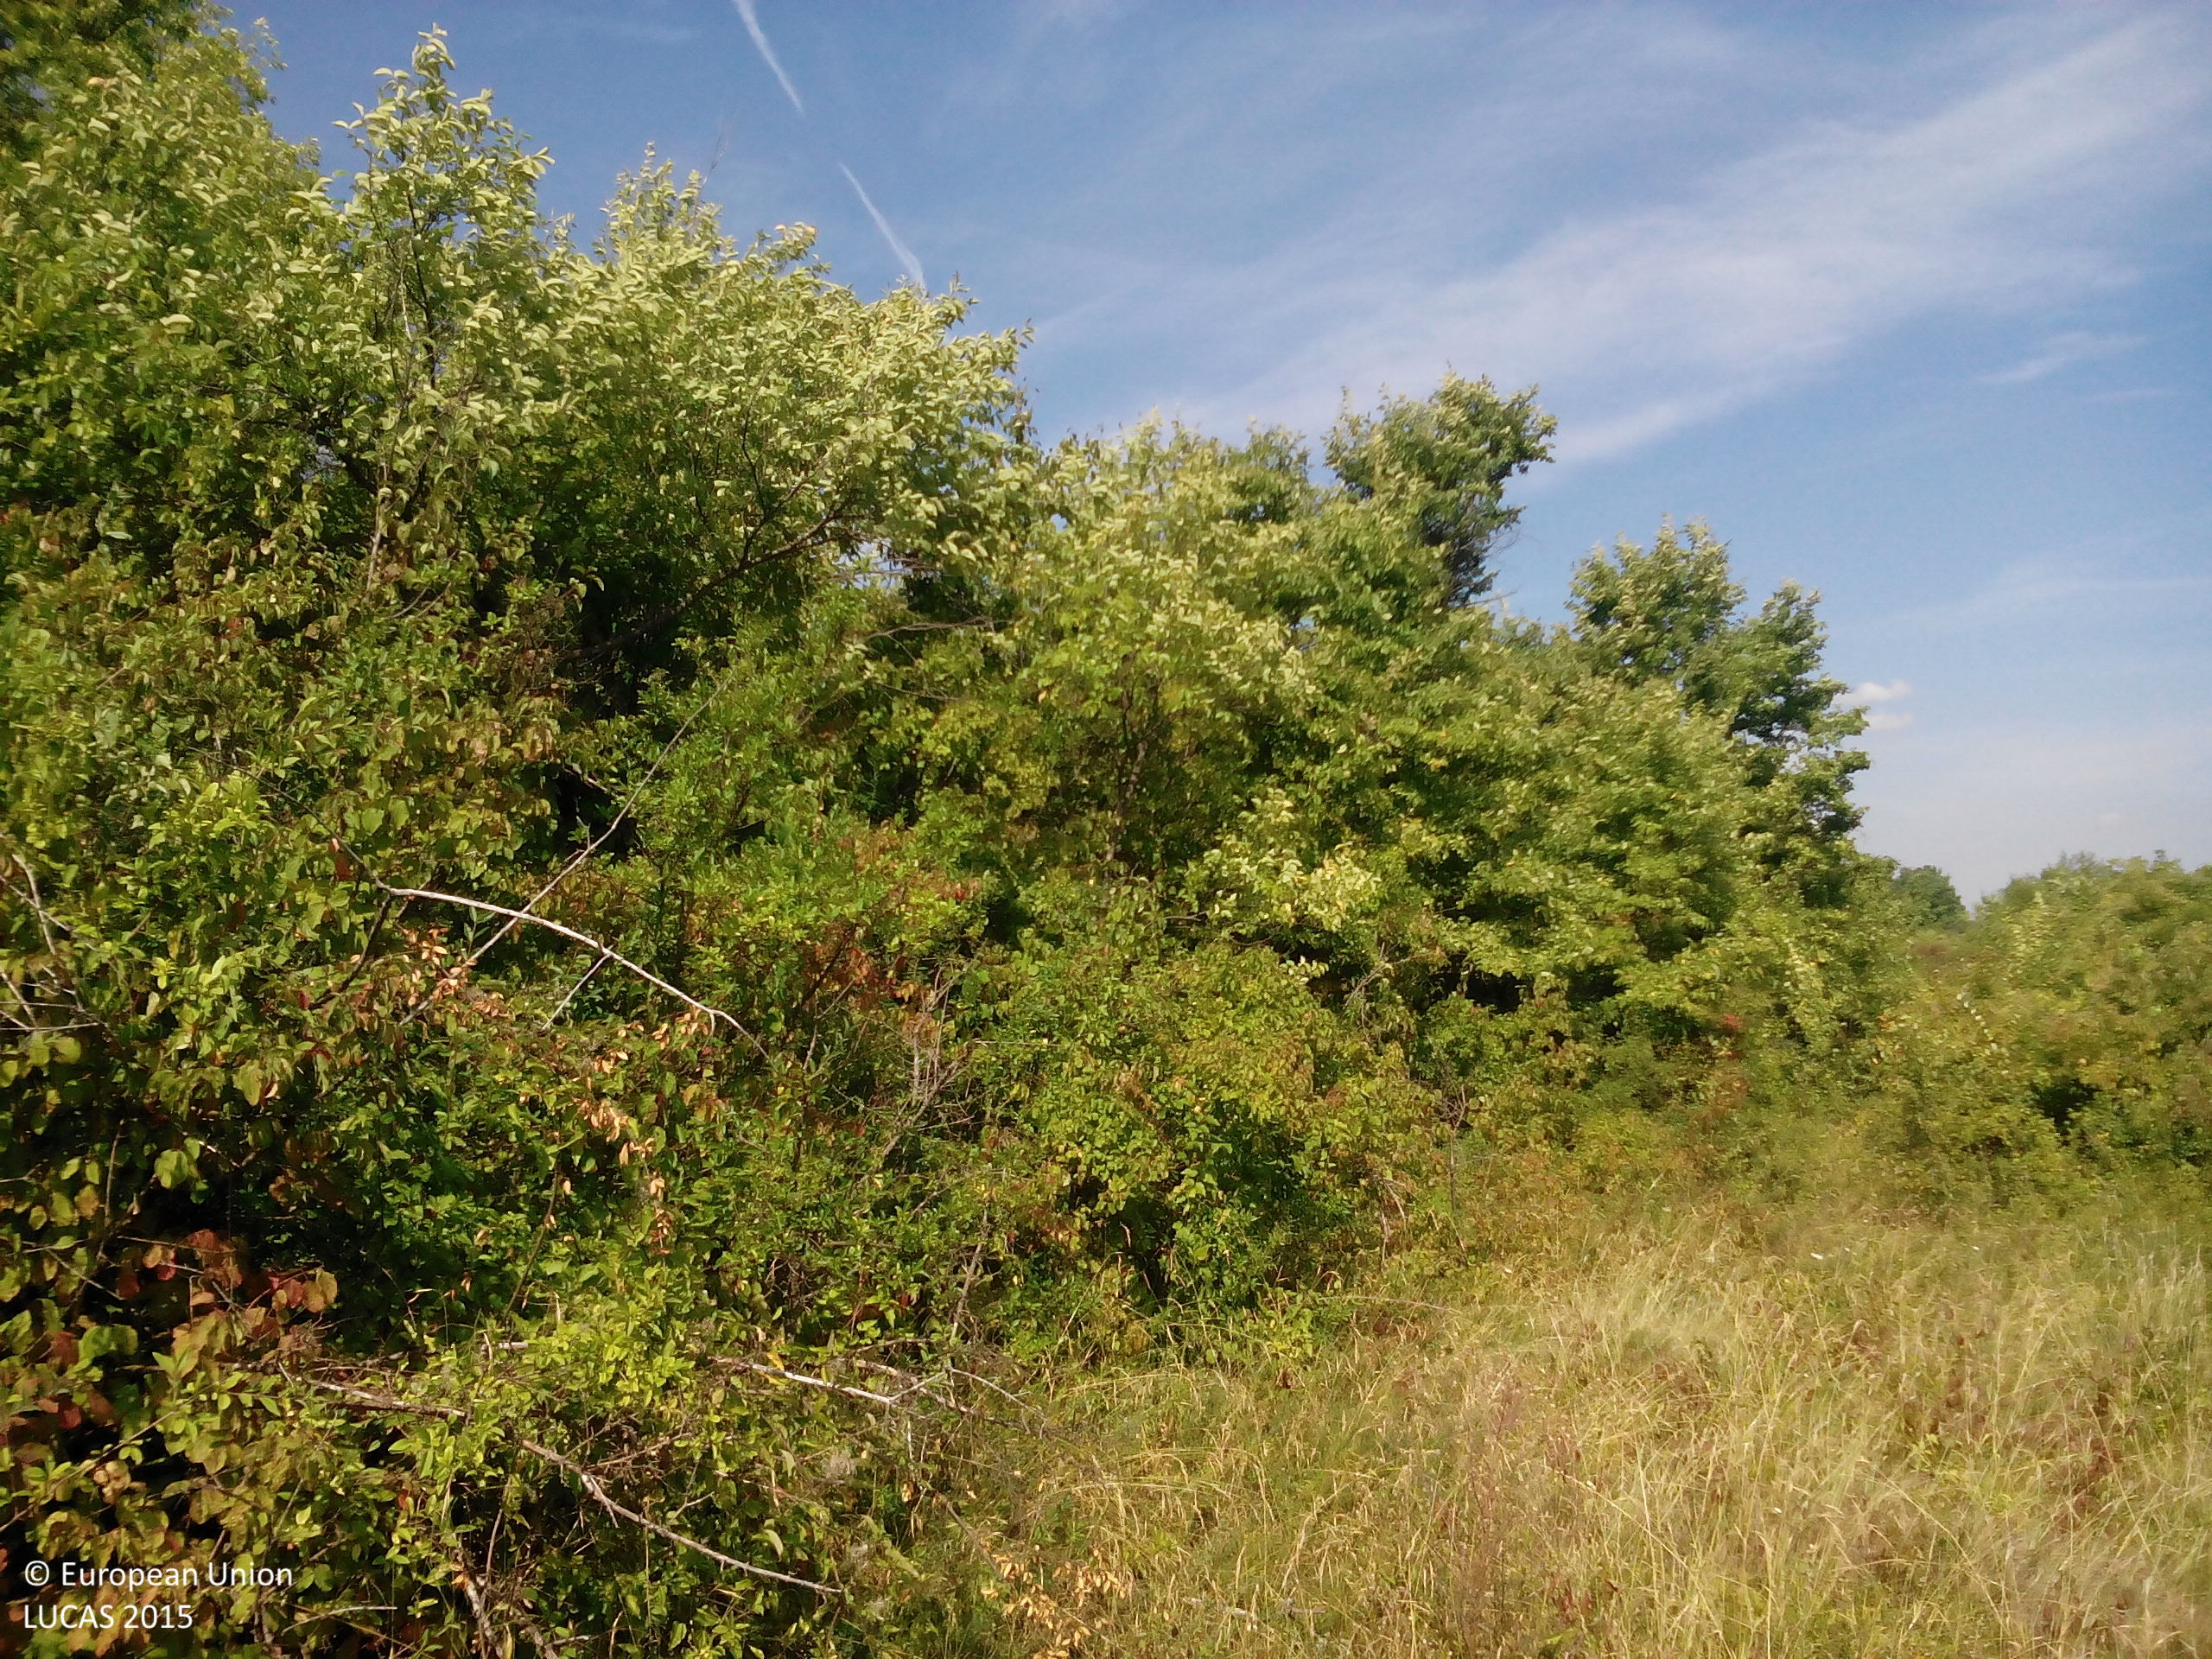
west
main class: Woodland
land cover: Broadleaved woodland
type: mesophytic deciduous forest
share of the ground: 25 - 50 %
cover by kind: shrubs 65 %, broadleaved forest trees 35 %
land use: Semi-natural and natural areas not in use
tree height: > 5 m
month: August
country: BG
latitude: 43.1517
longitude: 23.7815
